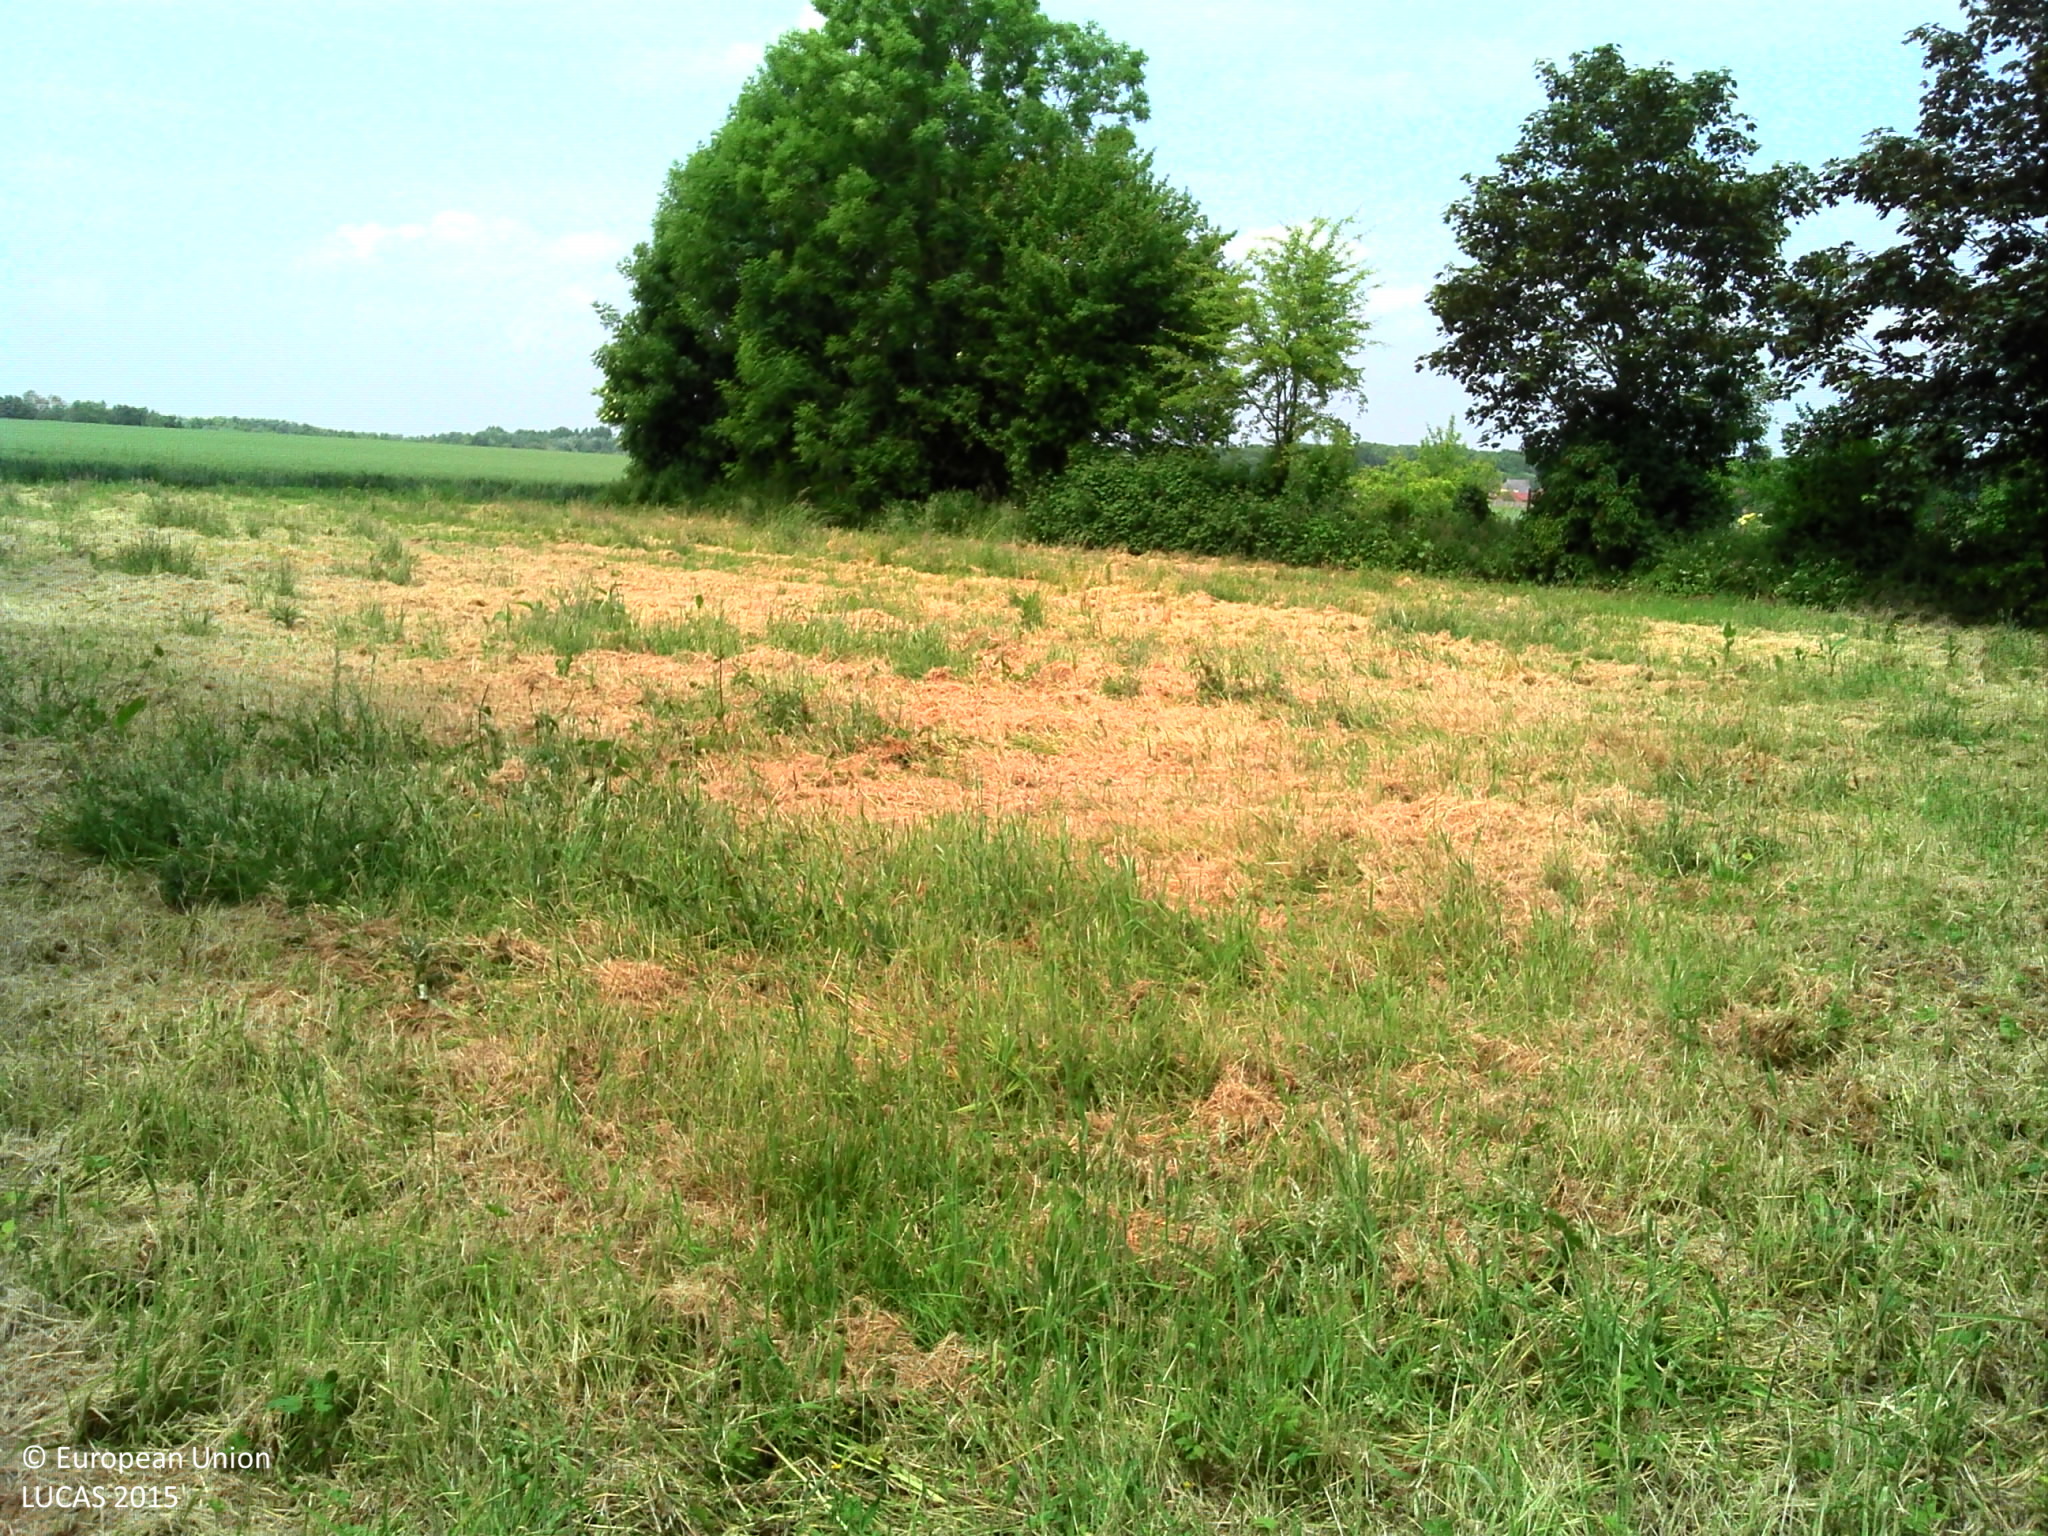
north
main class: Grassland
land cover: Grassland without tree/shrub cover
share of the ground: > 75 %
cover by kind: herbaceous plants 80 %
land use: Semi-natural and natural areas not in use
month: June
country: FR
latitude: 50.5112
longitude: 2.4426
